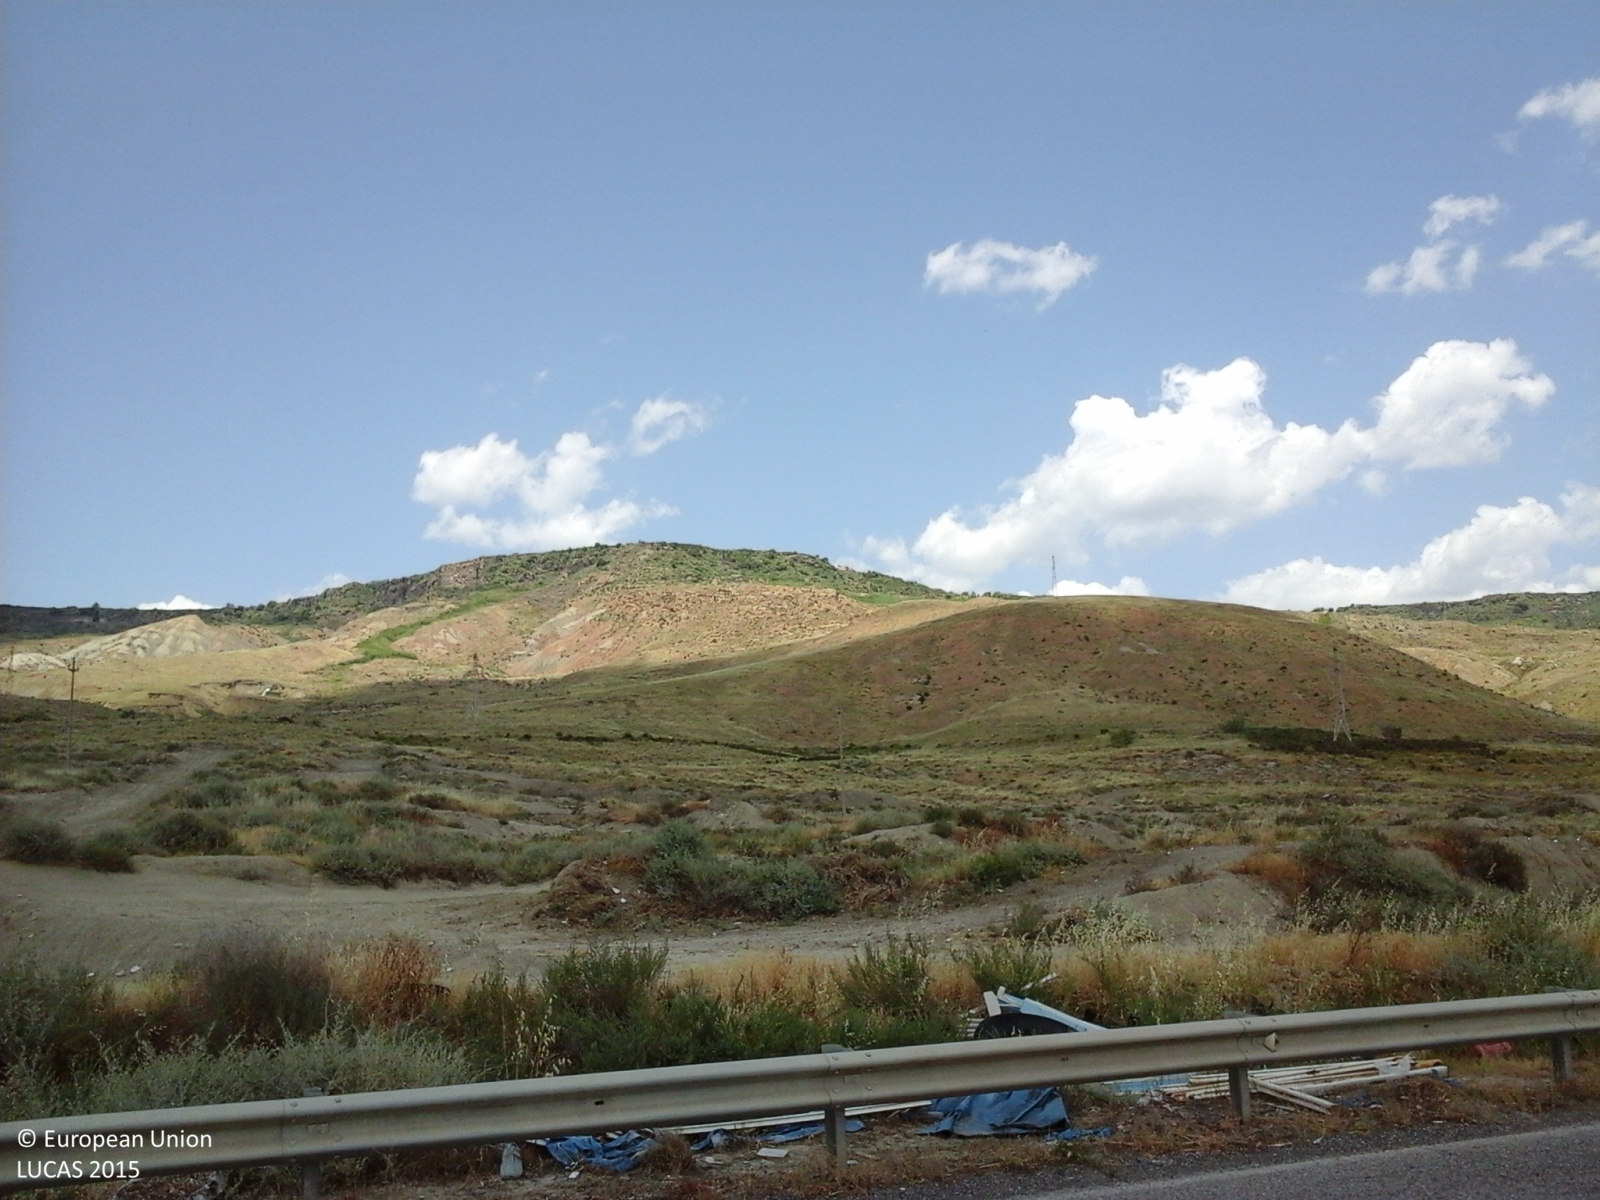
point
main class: Grassland
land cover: Grassland without tree/shrub cover
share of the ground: > 75 %
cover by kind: herbaceous plants 100 %
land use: Agriculture (excluding fallow land and kitchen gardens)
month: May
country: IT
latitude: 37.6431
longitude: 14.8277
